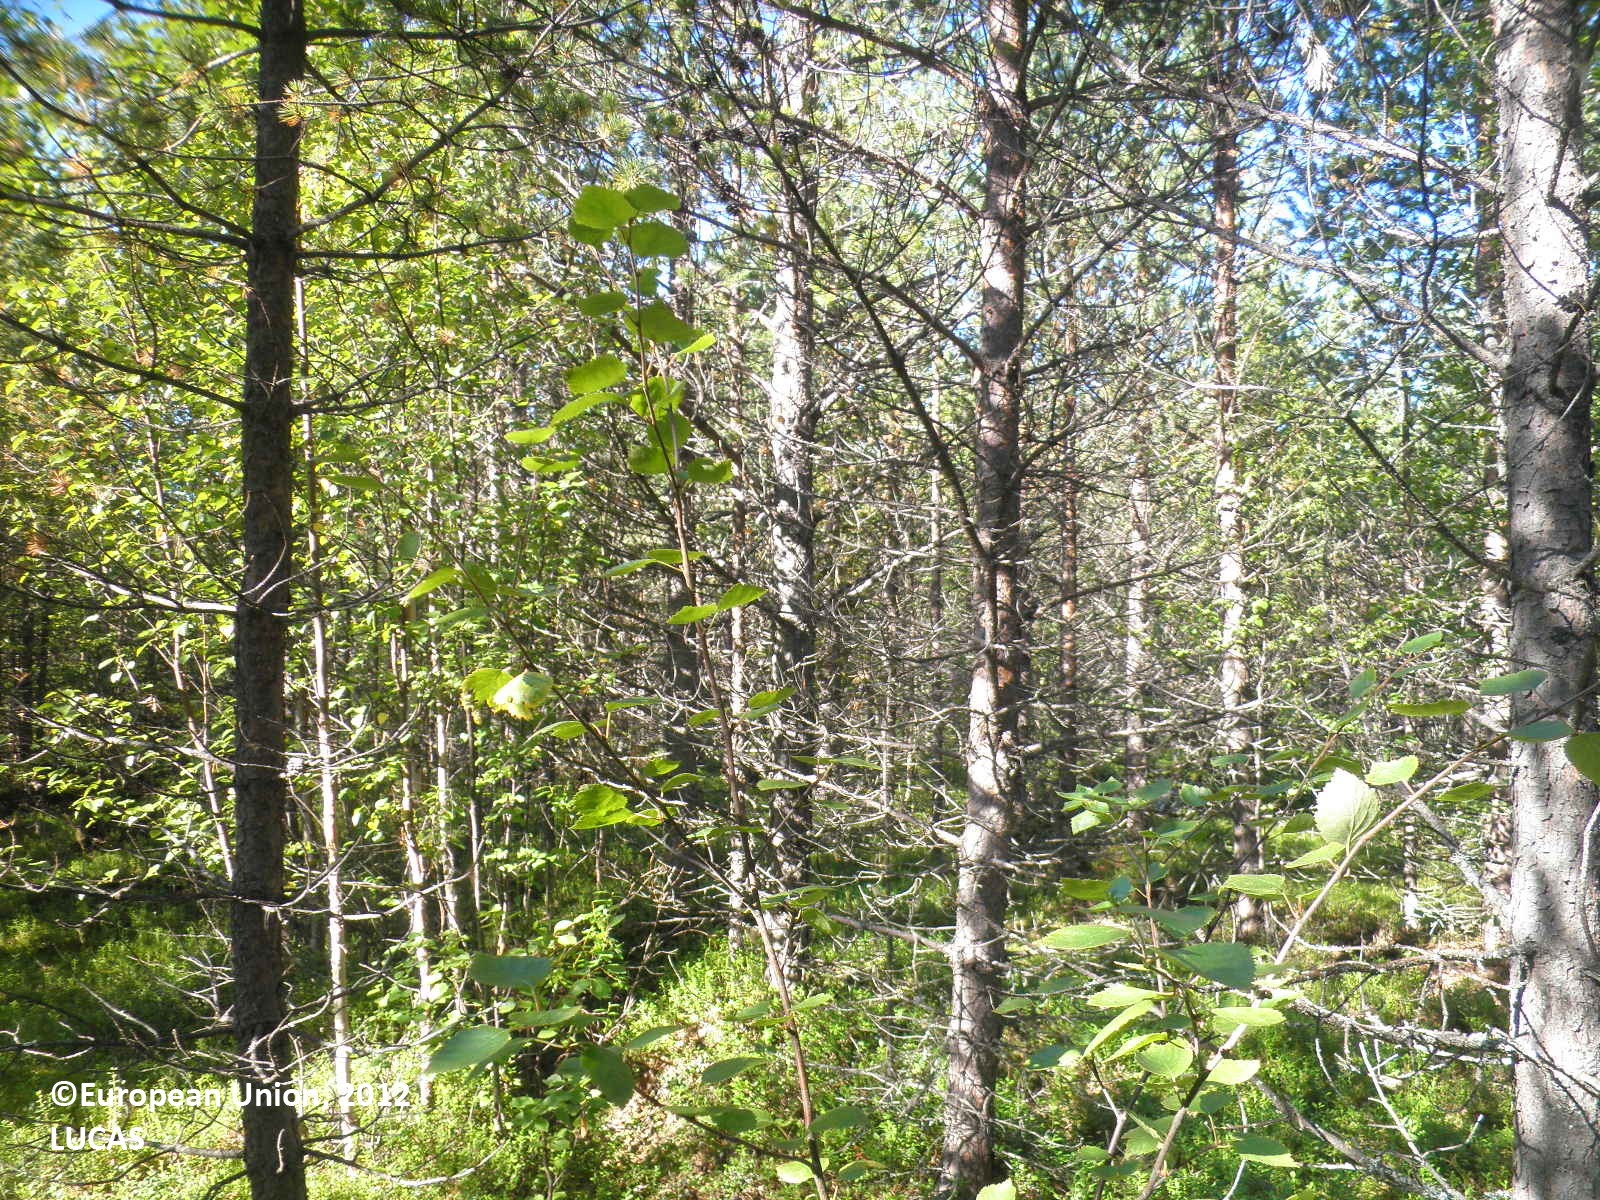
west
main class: Woodland
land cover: Pine dominated mixed woodland
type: boreal forest
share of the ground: 50 - 75 %
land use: Forestry
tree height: > 5 m
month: August
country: FI
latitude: 67.6556
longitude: 25.4372
